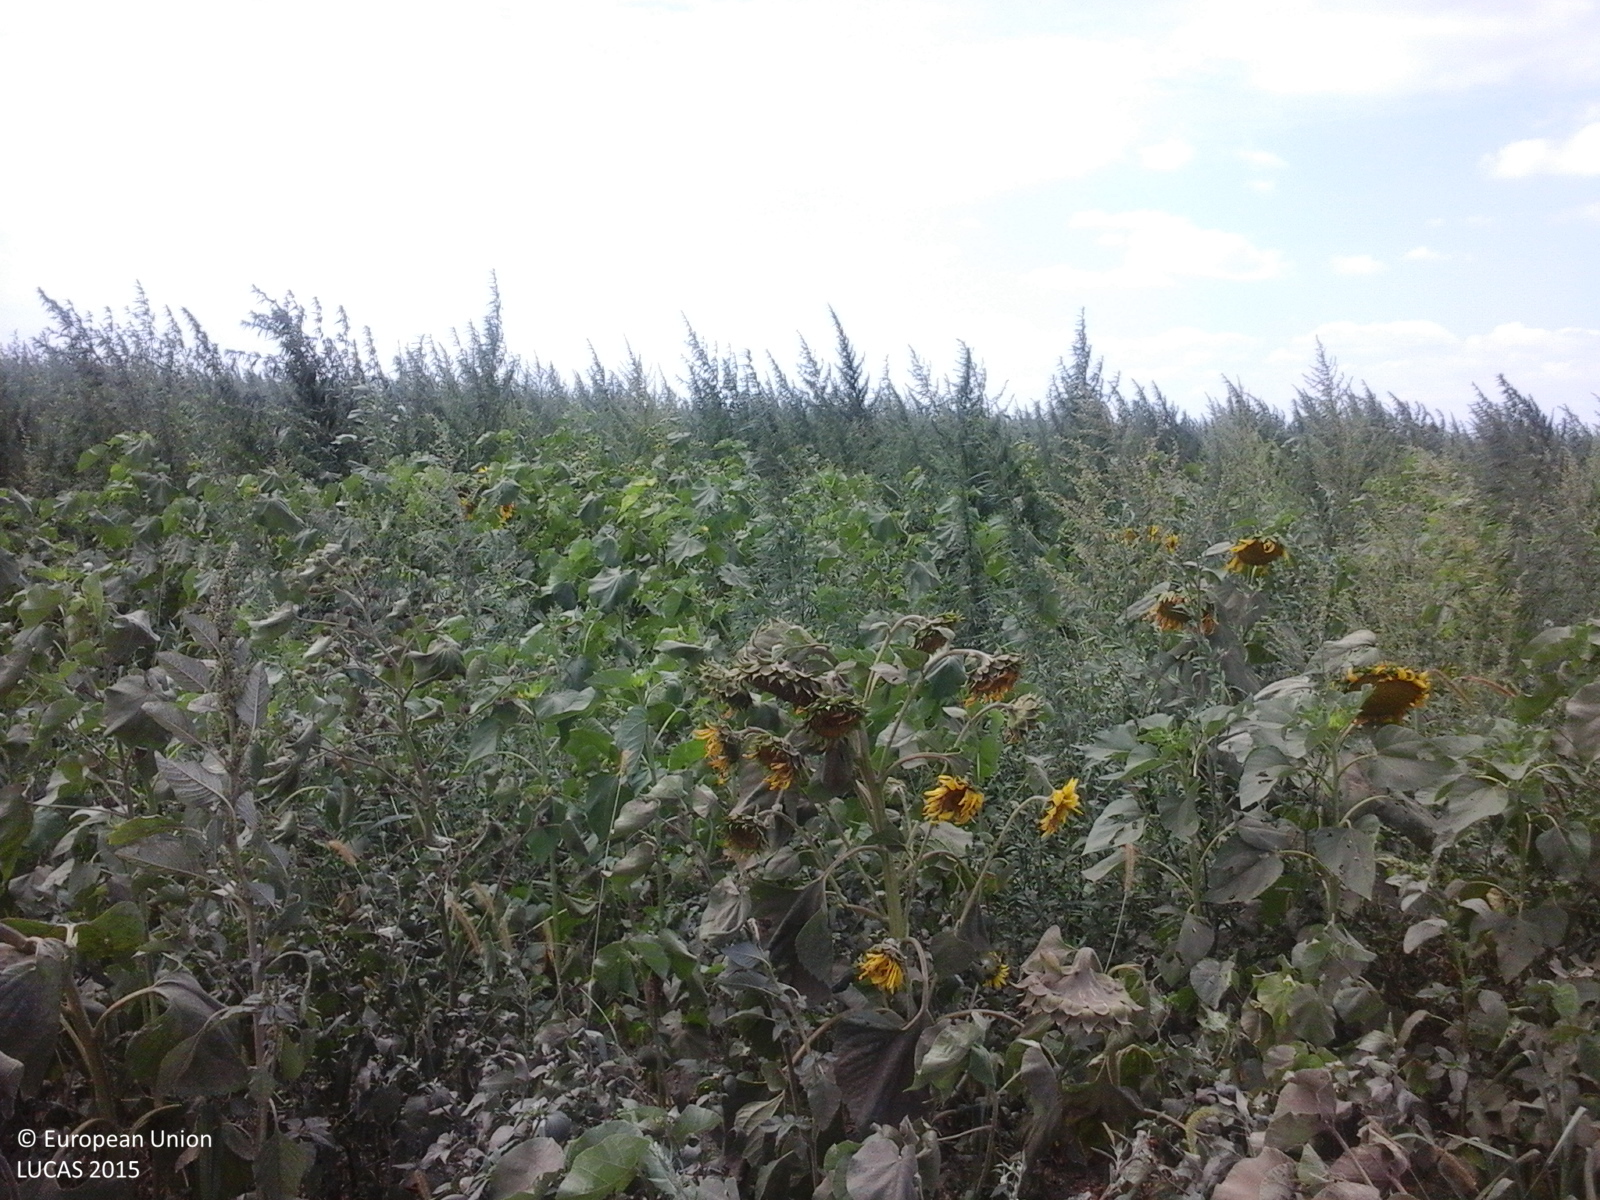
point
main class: Cropland
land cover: Sunflower
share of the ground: 50 - 75 %
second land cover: Spontaneously vegetated surfaces
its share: 25 - 50 %
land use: Agriculture (excluding fallow land and kitchen gardens)
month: August
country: RO
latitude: 45.3126
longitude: 29.0944
